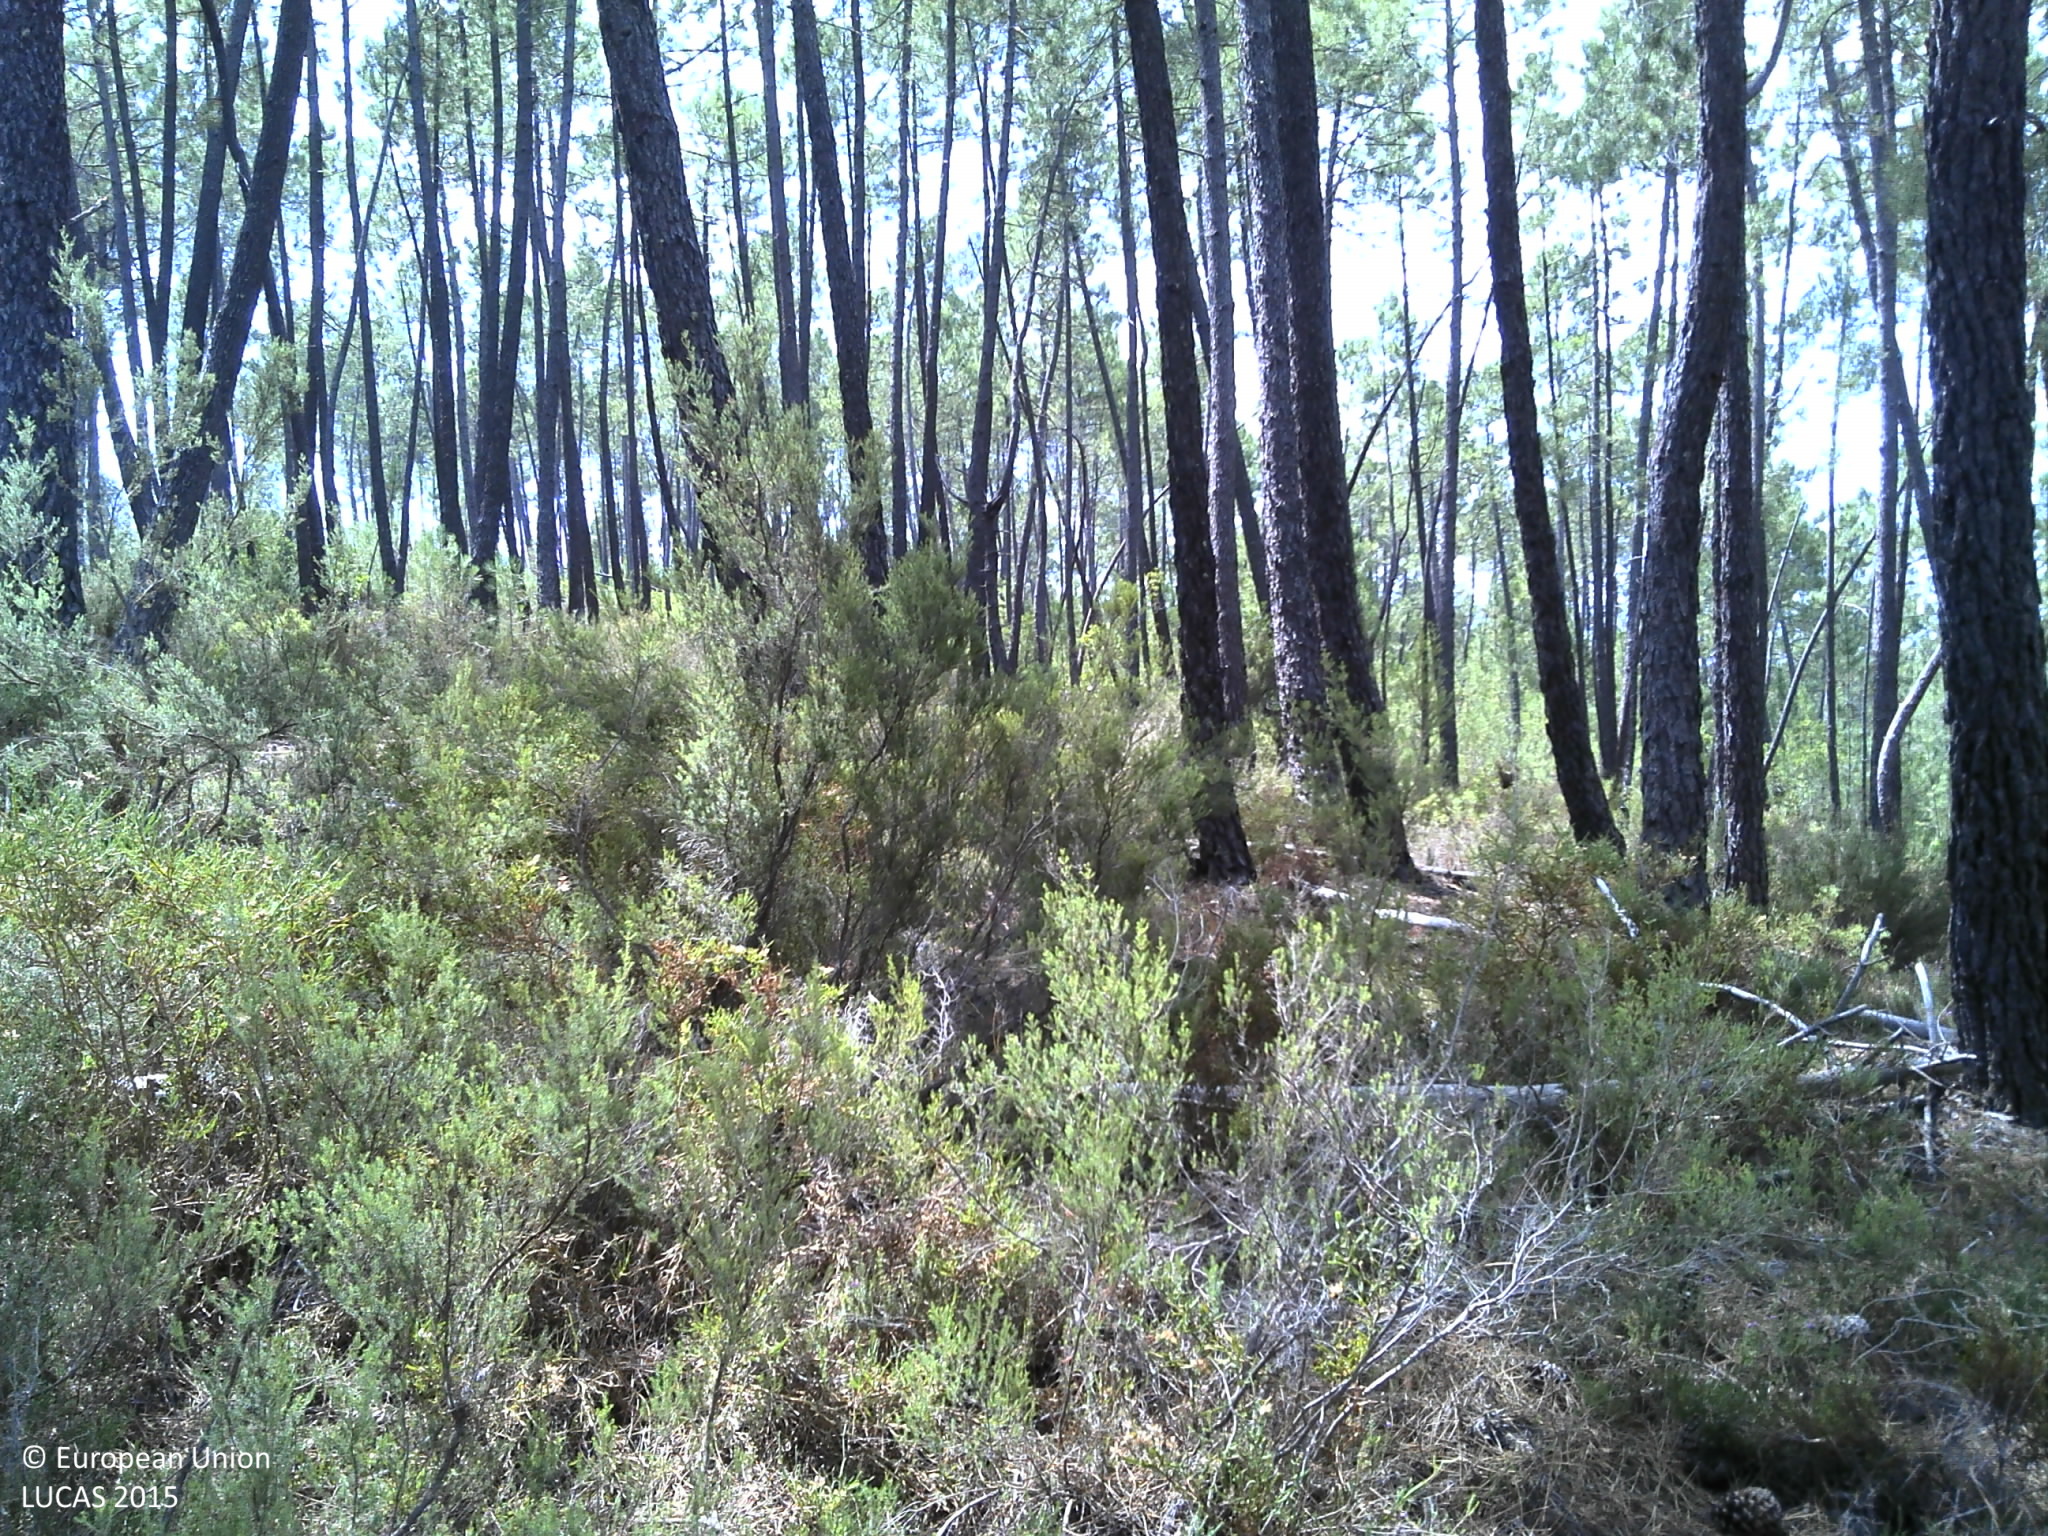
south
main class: Woodland
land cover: Pine dominated coniferous woodland
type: coniferous forest of the mediterranean region
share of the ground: 10 - 25 %
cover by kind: shrubs 50 %, unconsolidated bare surface 35 %, coniferous forest trees 15 %
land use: Forestry
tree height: > 5 m
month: July
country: PT
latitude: 39.8768
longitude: -7.8220
